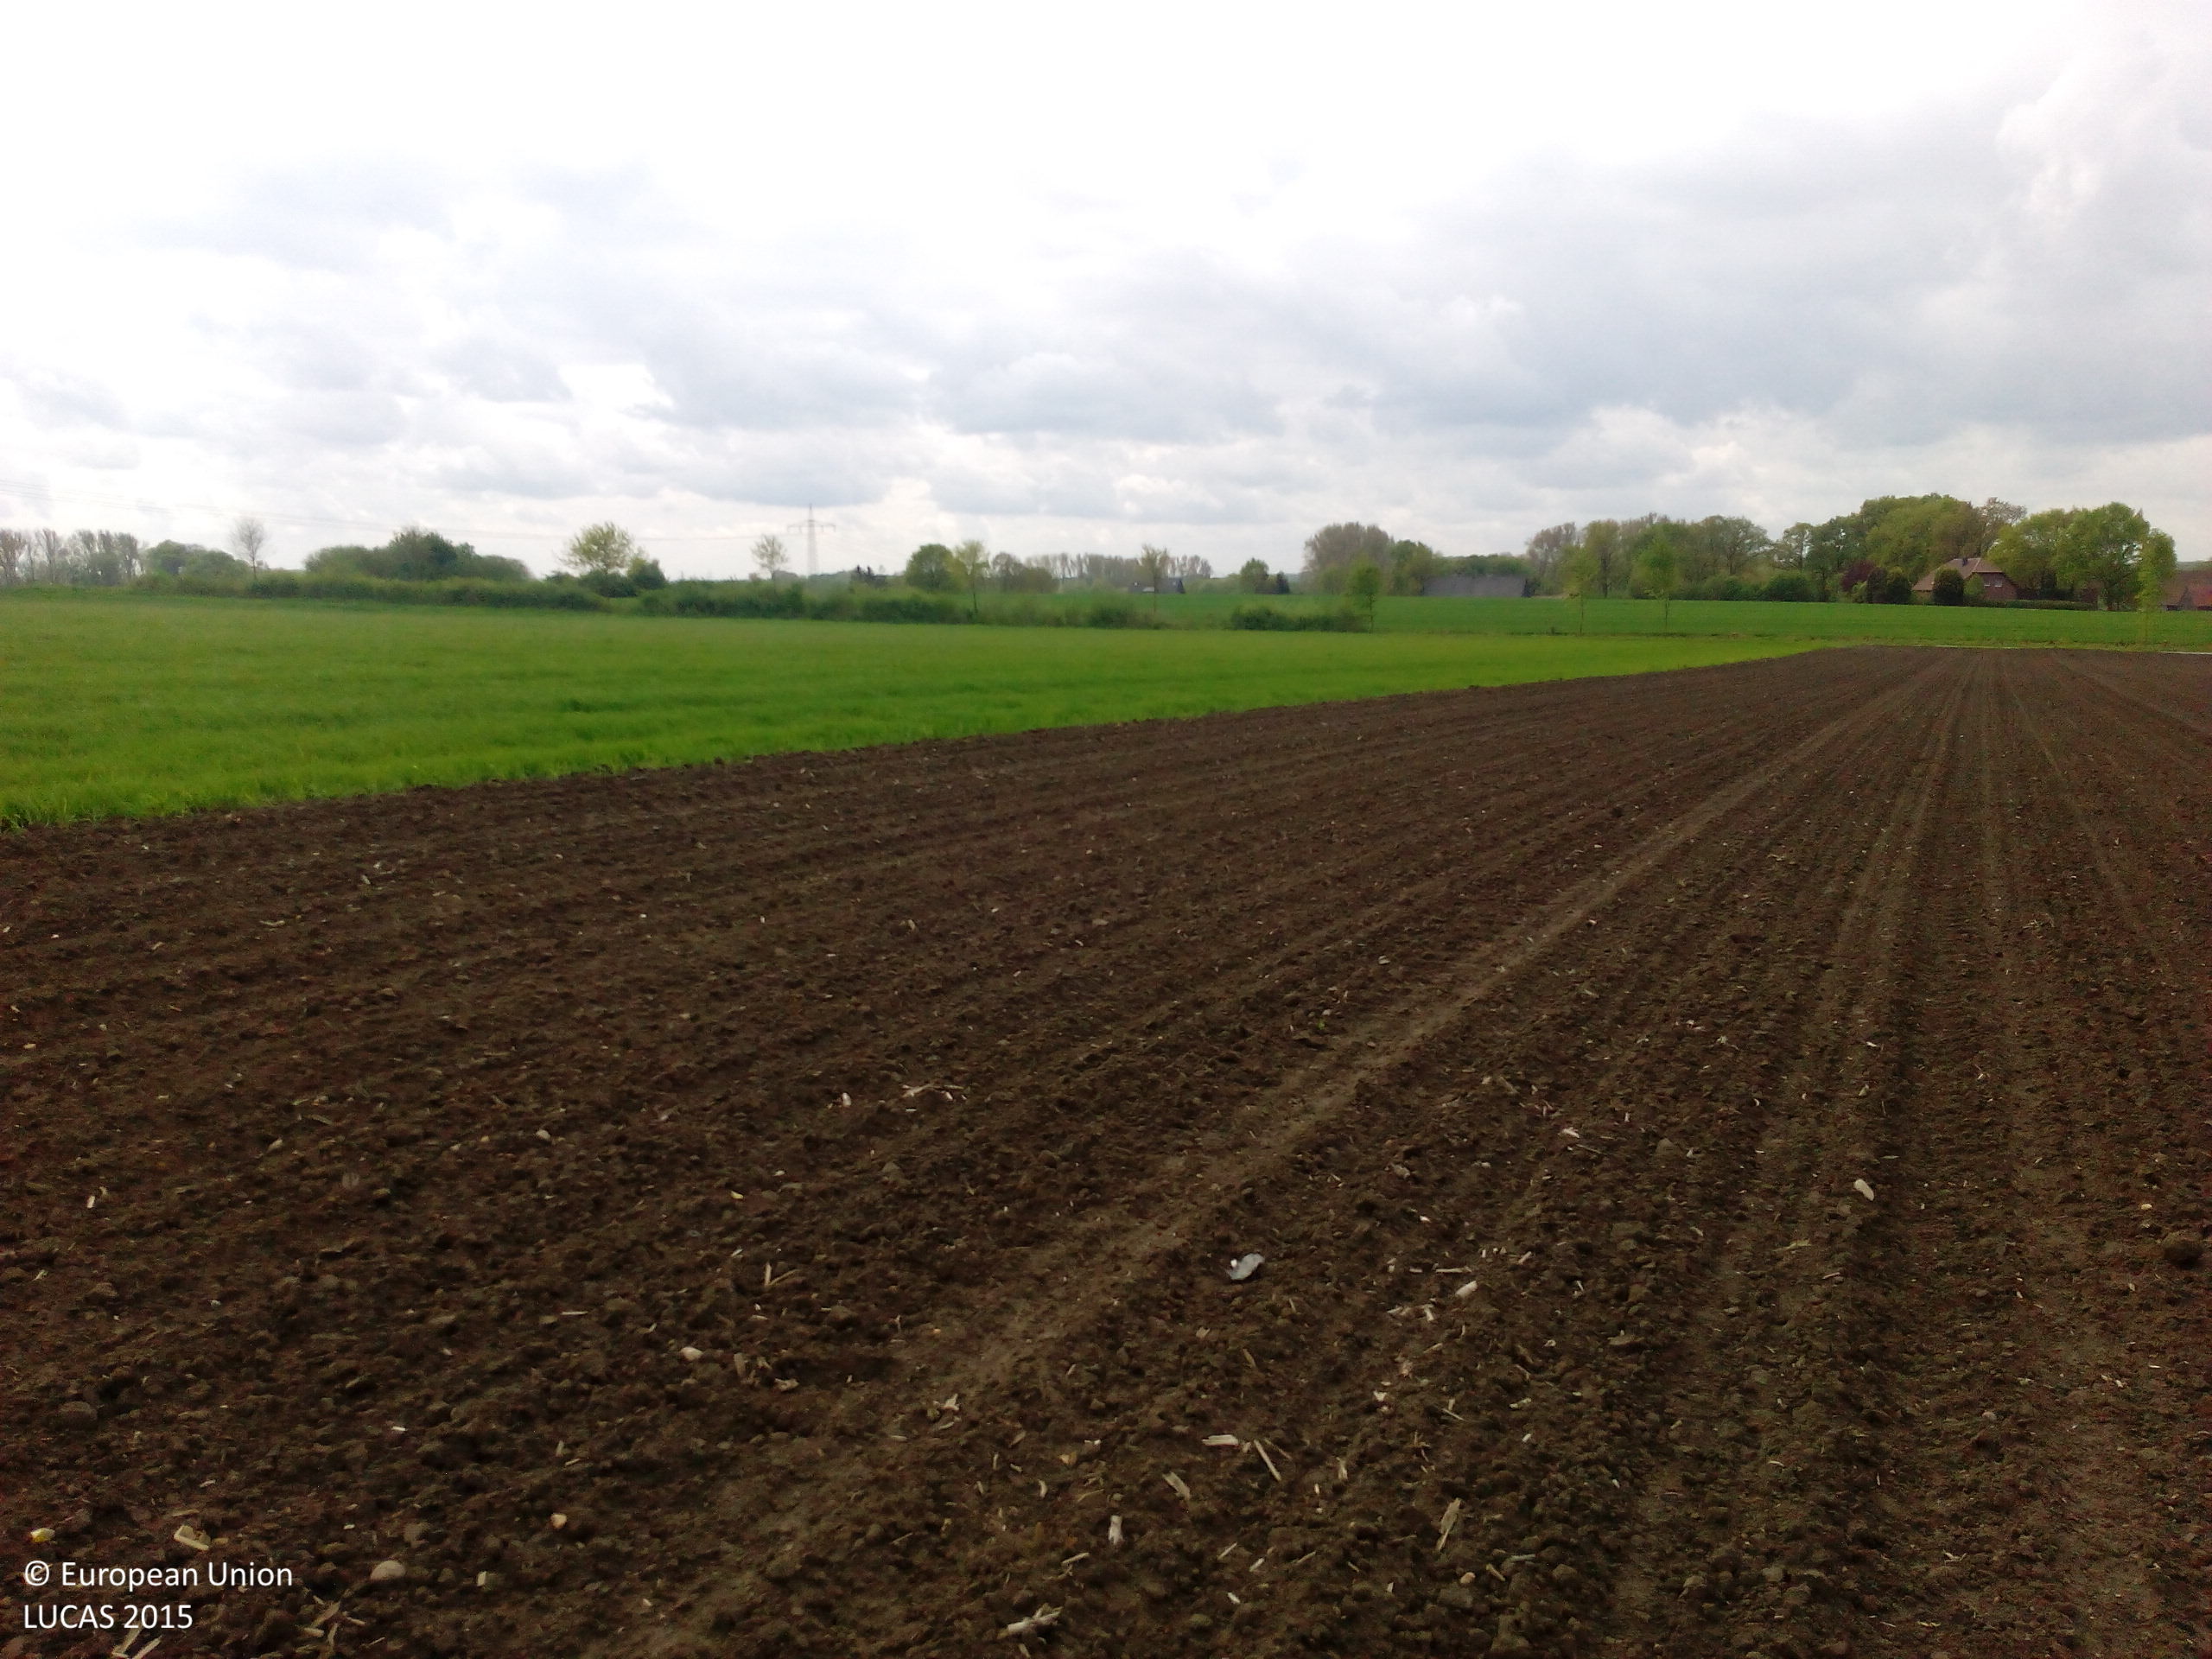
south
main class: Cropland
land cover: Maize
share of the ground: < 10 %
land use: Agriculture (excluding fallow land and kitchen gardens)
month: May
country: DE
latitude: 51.6832
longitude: 7.3823
